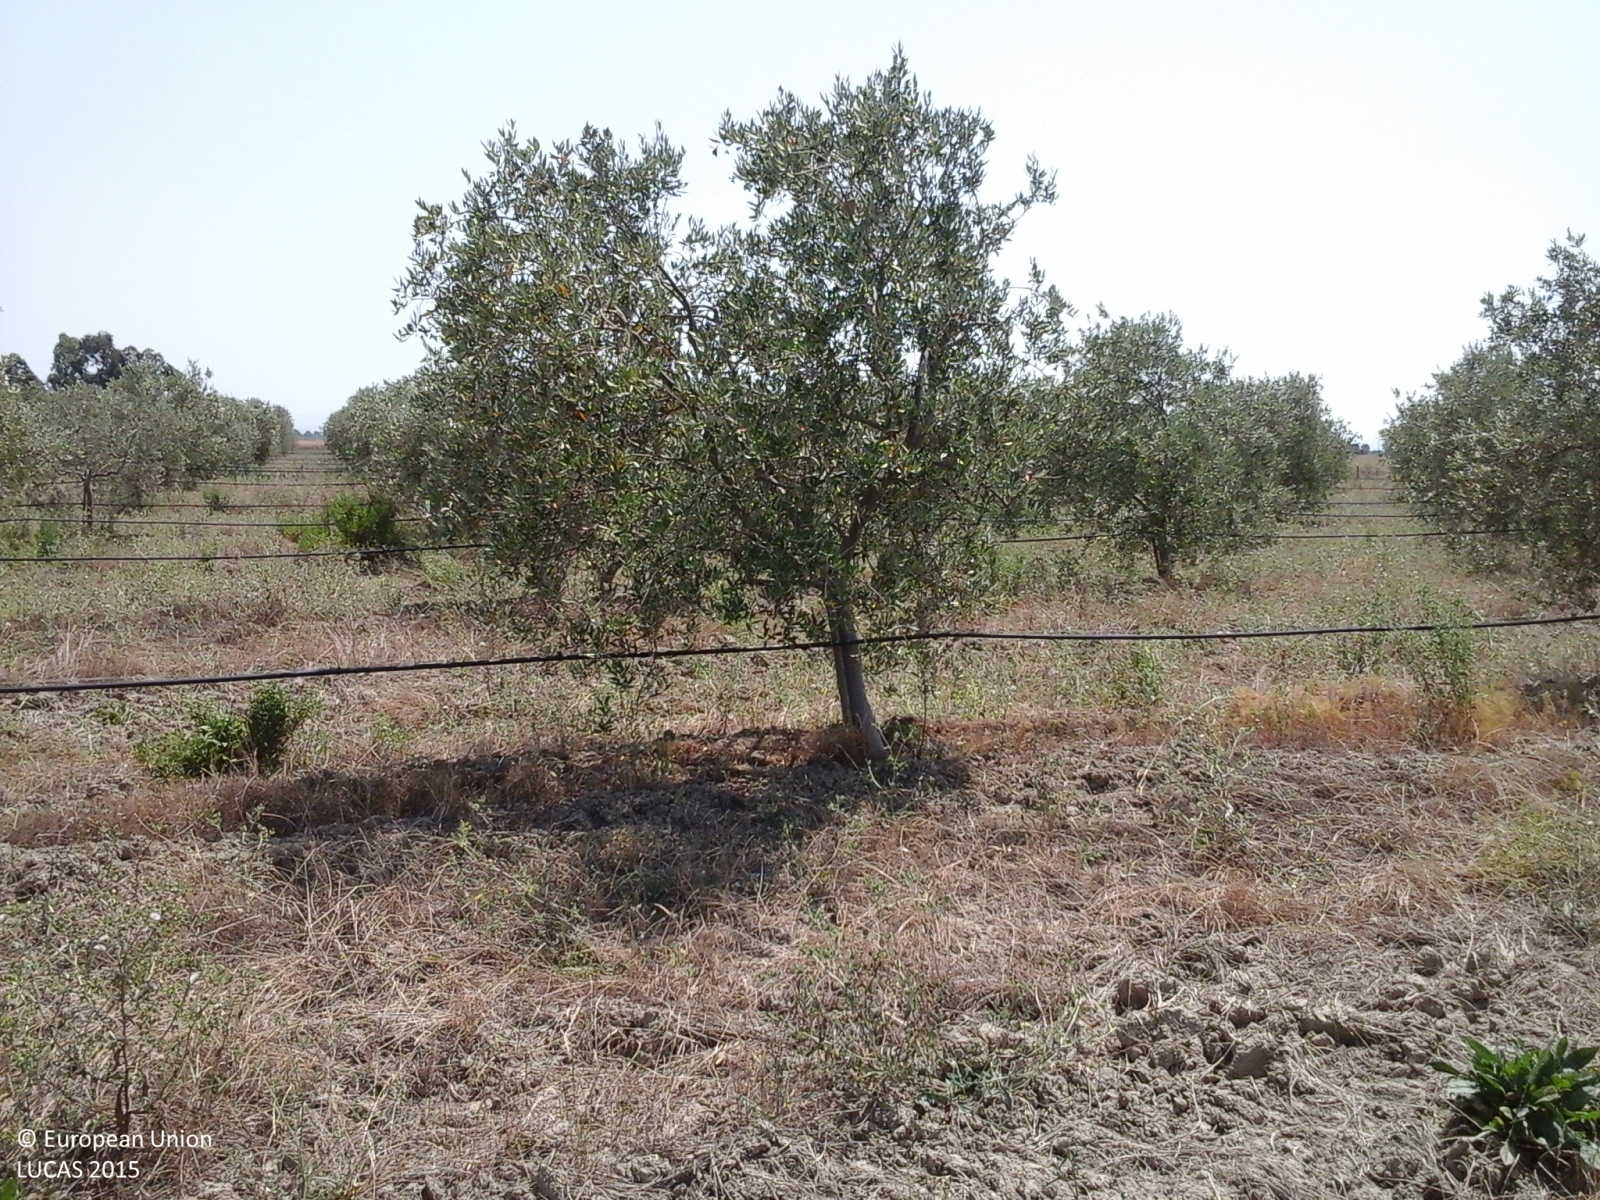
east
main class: Cropland
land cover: Olive groves
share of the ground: 50 - 75 %
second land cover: Grassland without tree/shrub cover
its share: 50 - 75 %
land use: Agriculture (excluding fallow land and kitchen gardens)
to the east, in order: Olive groves; Grassland without tree/shrub cover; Ditches and canals; Lucerne; Ditches and canals; Lucerne; Ditches and canals; Lucerne; Ditches and canals; Lucerne; Ditches and canals; Tracks; Clovers
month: July
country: IT
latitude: 42.7576
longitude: 10.9865
